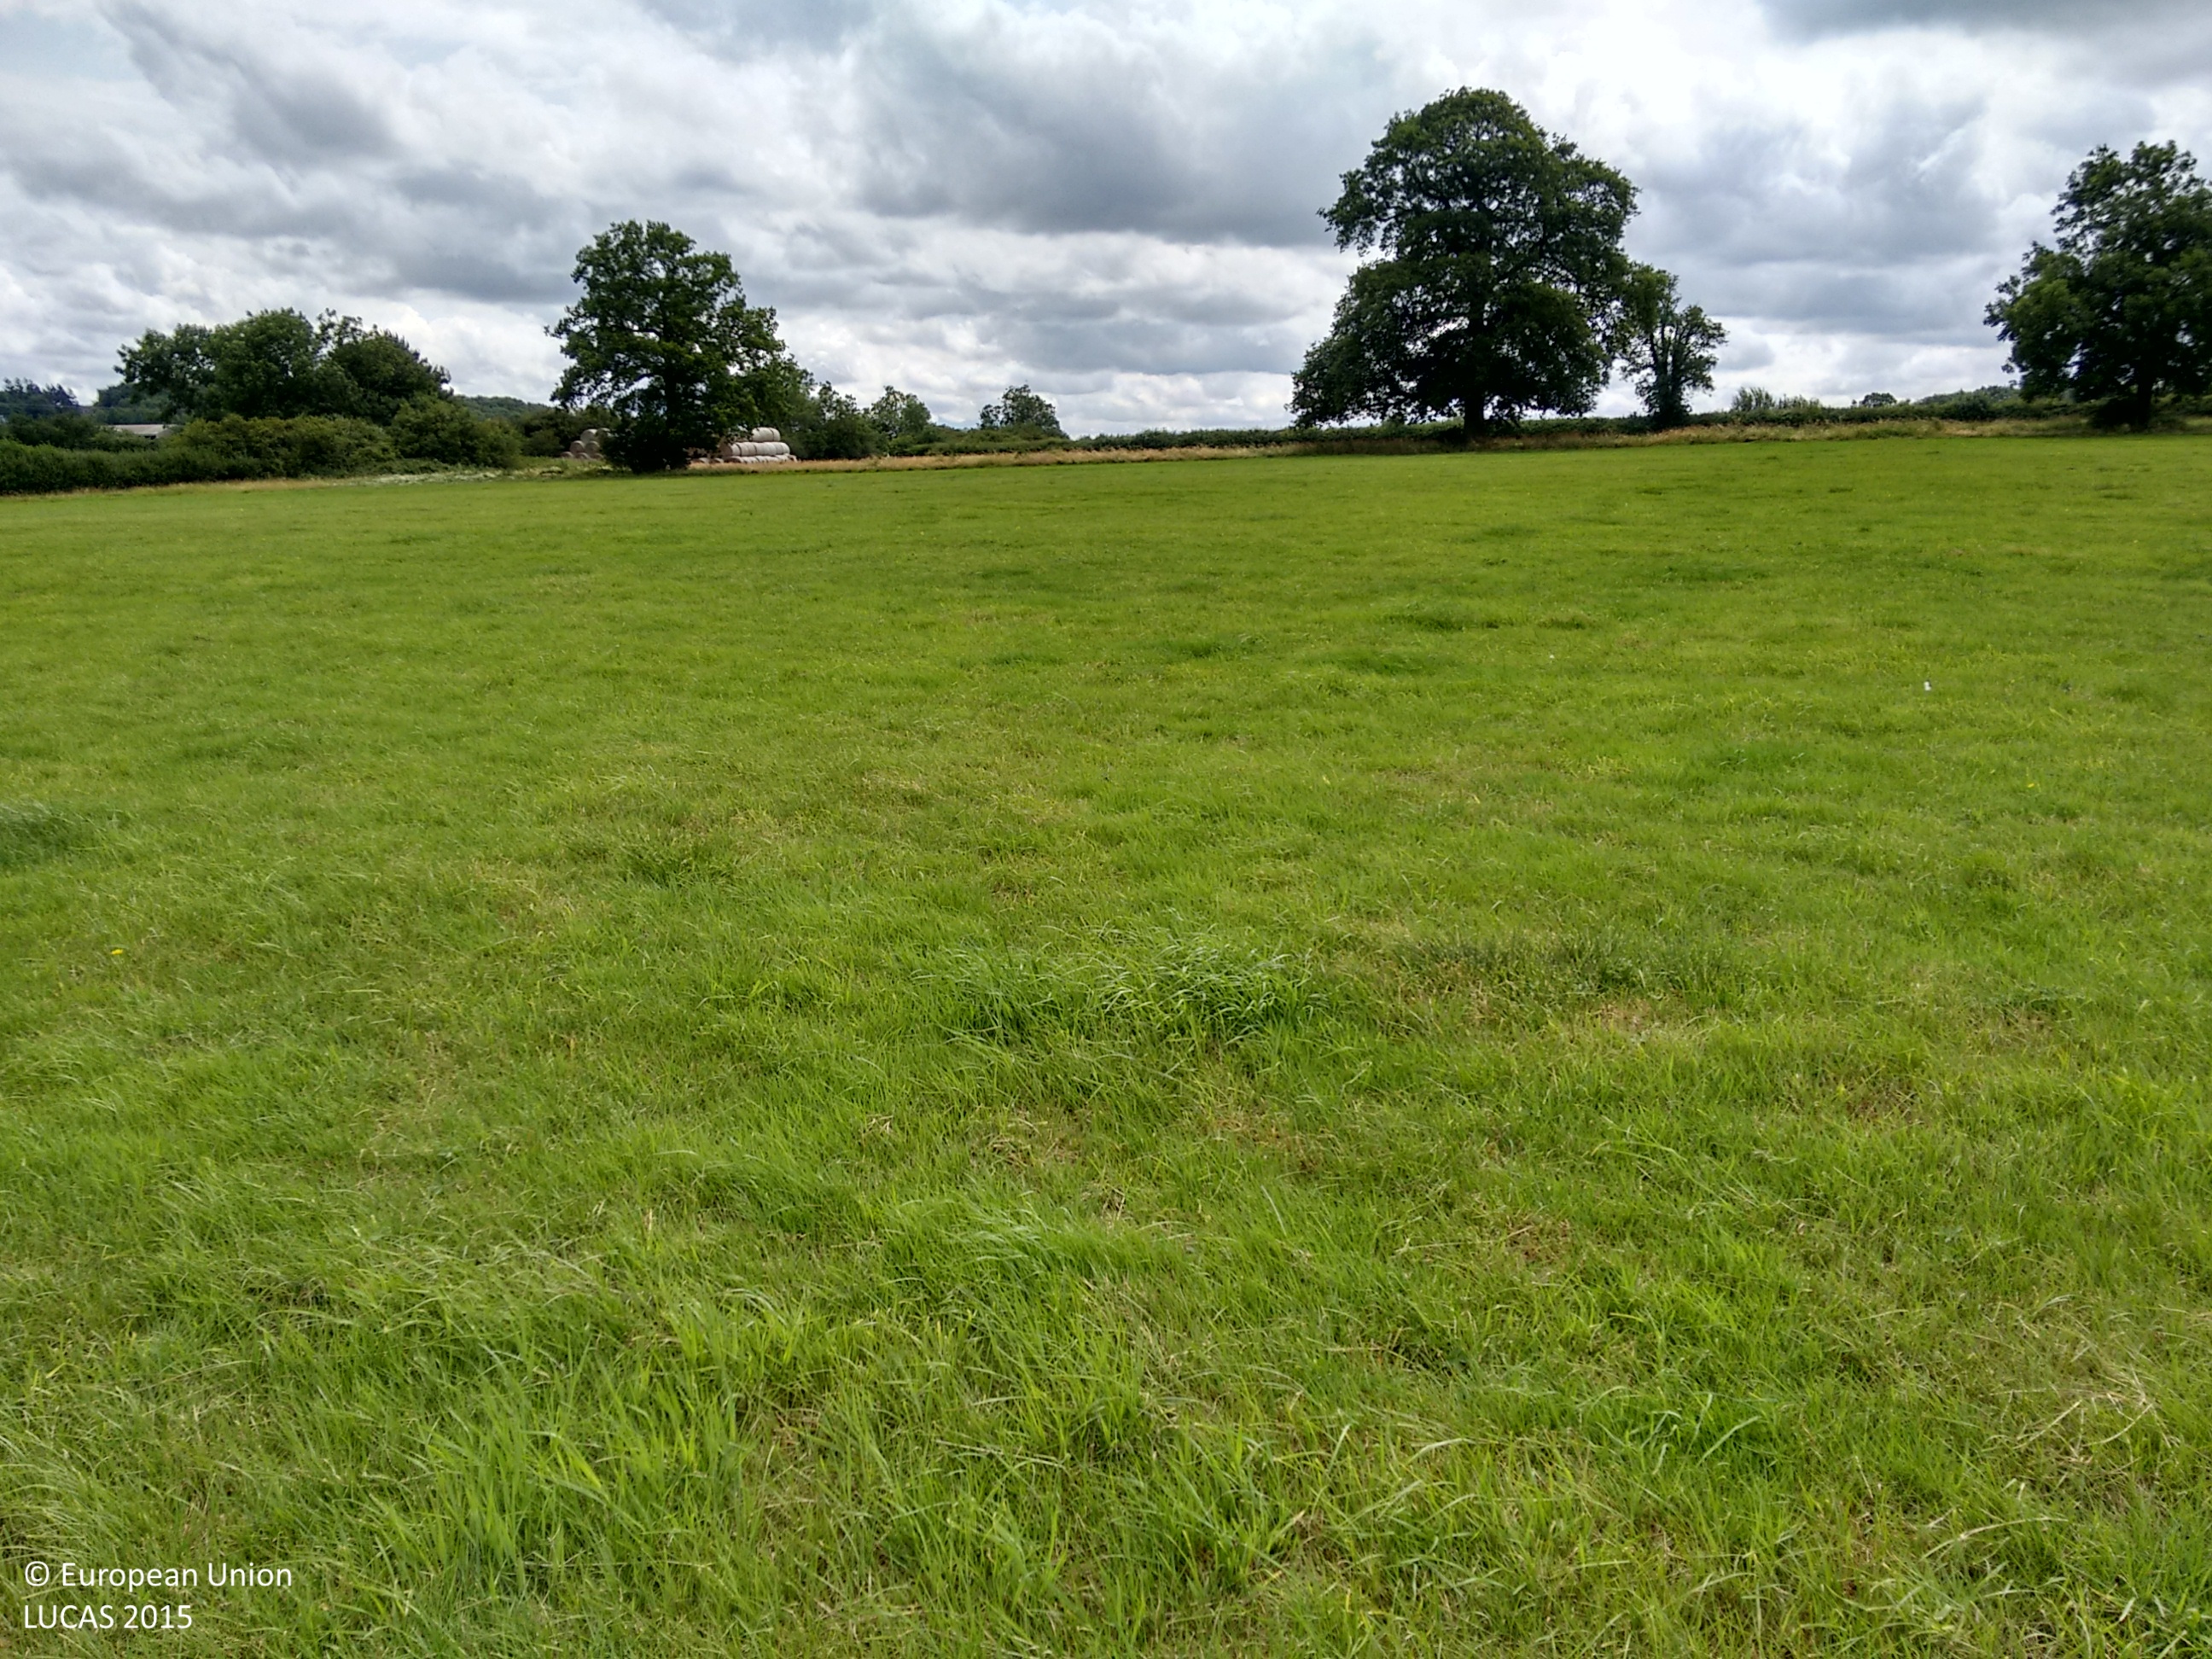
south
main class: Grassland
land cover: Grassland without tree/shrub cover
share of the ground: > 75 %
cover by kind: herbaceous plants 100 %
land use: Agriculture (excluding fallow land and kitchen gardens)
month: July
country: GB
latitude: 52.6899
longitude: -0.7074
